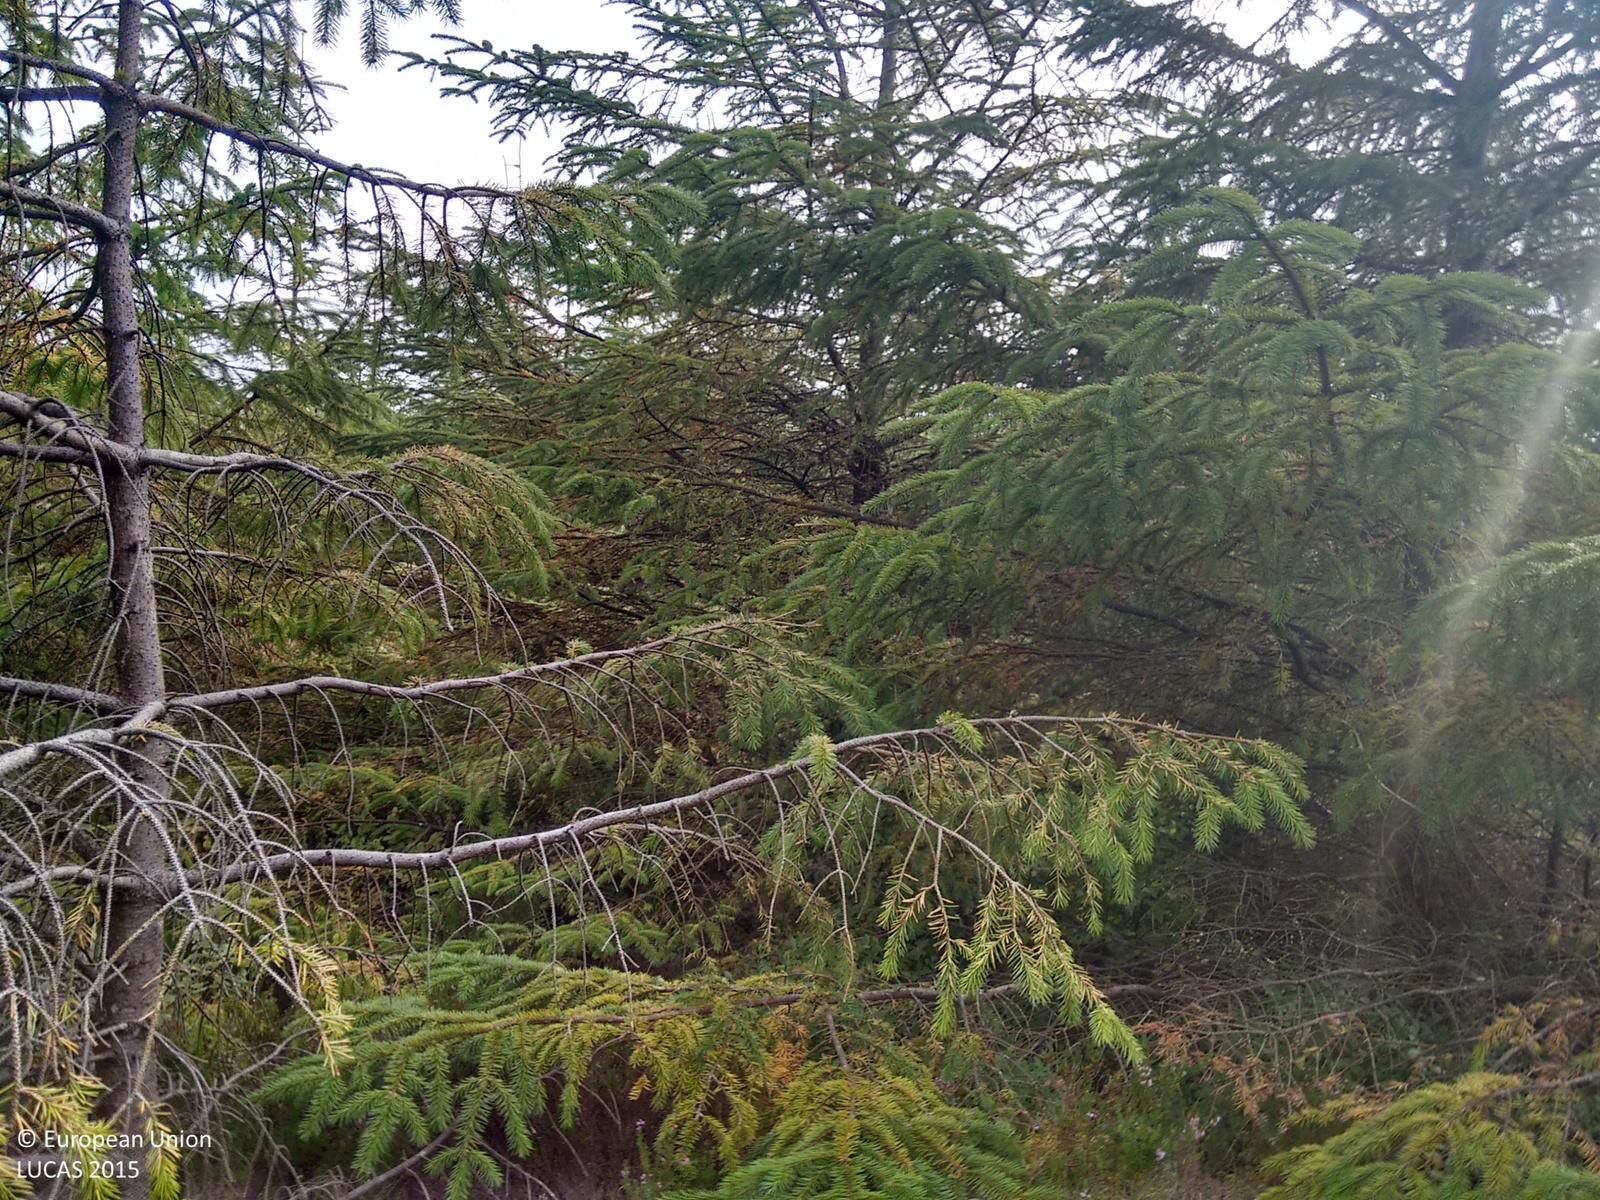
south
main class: Woodland
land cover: Pine dominated coniferous woodland
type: exotic forest
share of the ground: > 75 %
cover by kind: coniferous forest trees 80 %, herbaceous plants 15 %, shrubs 5 %
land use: Forestry
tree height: < 5 m
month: September
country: IE
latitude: 52.4434
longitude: -9.1532
